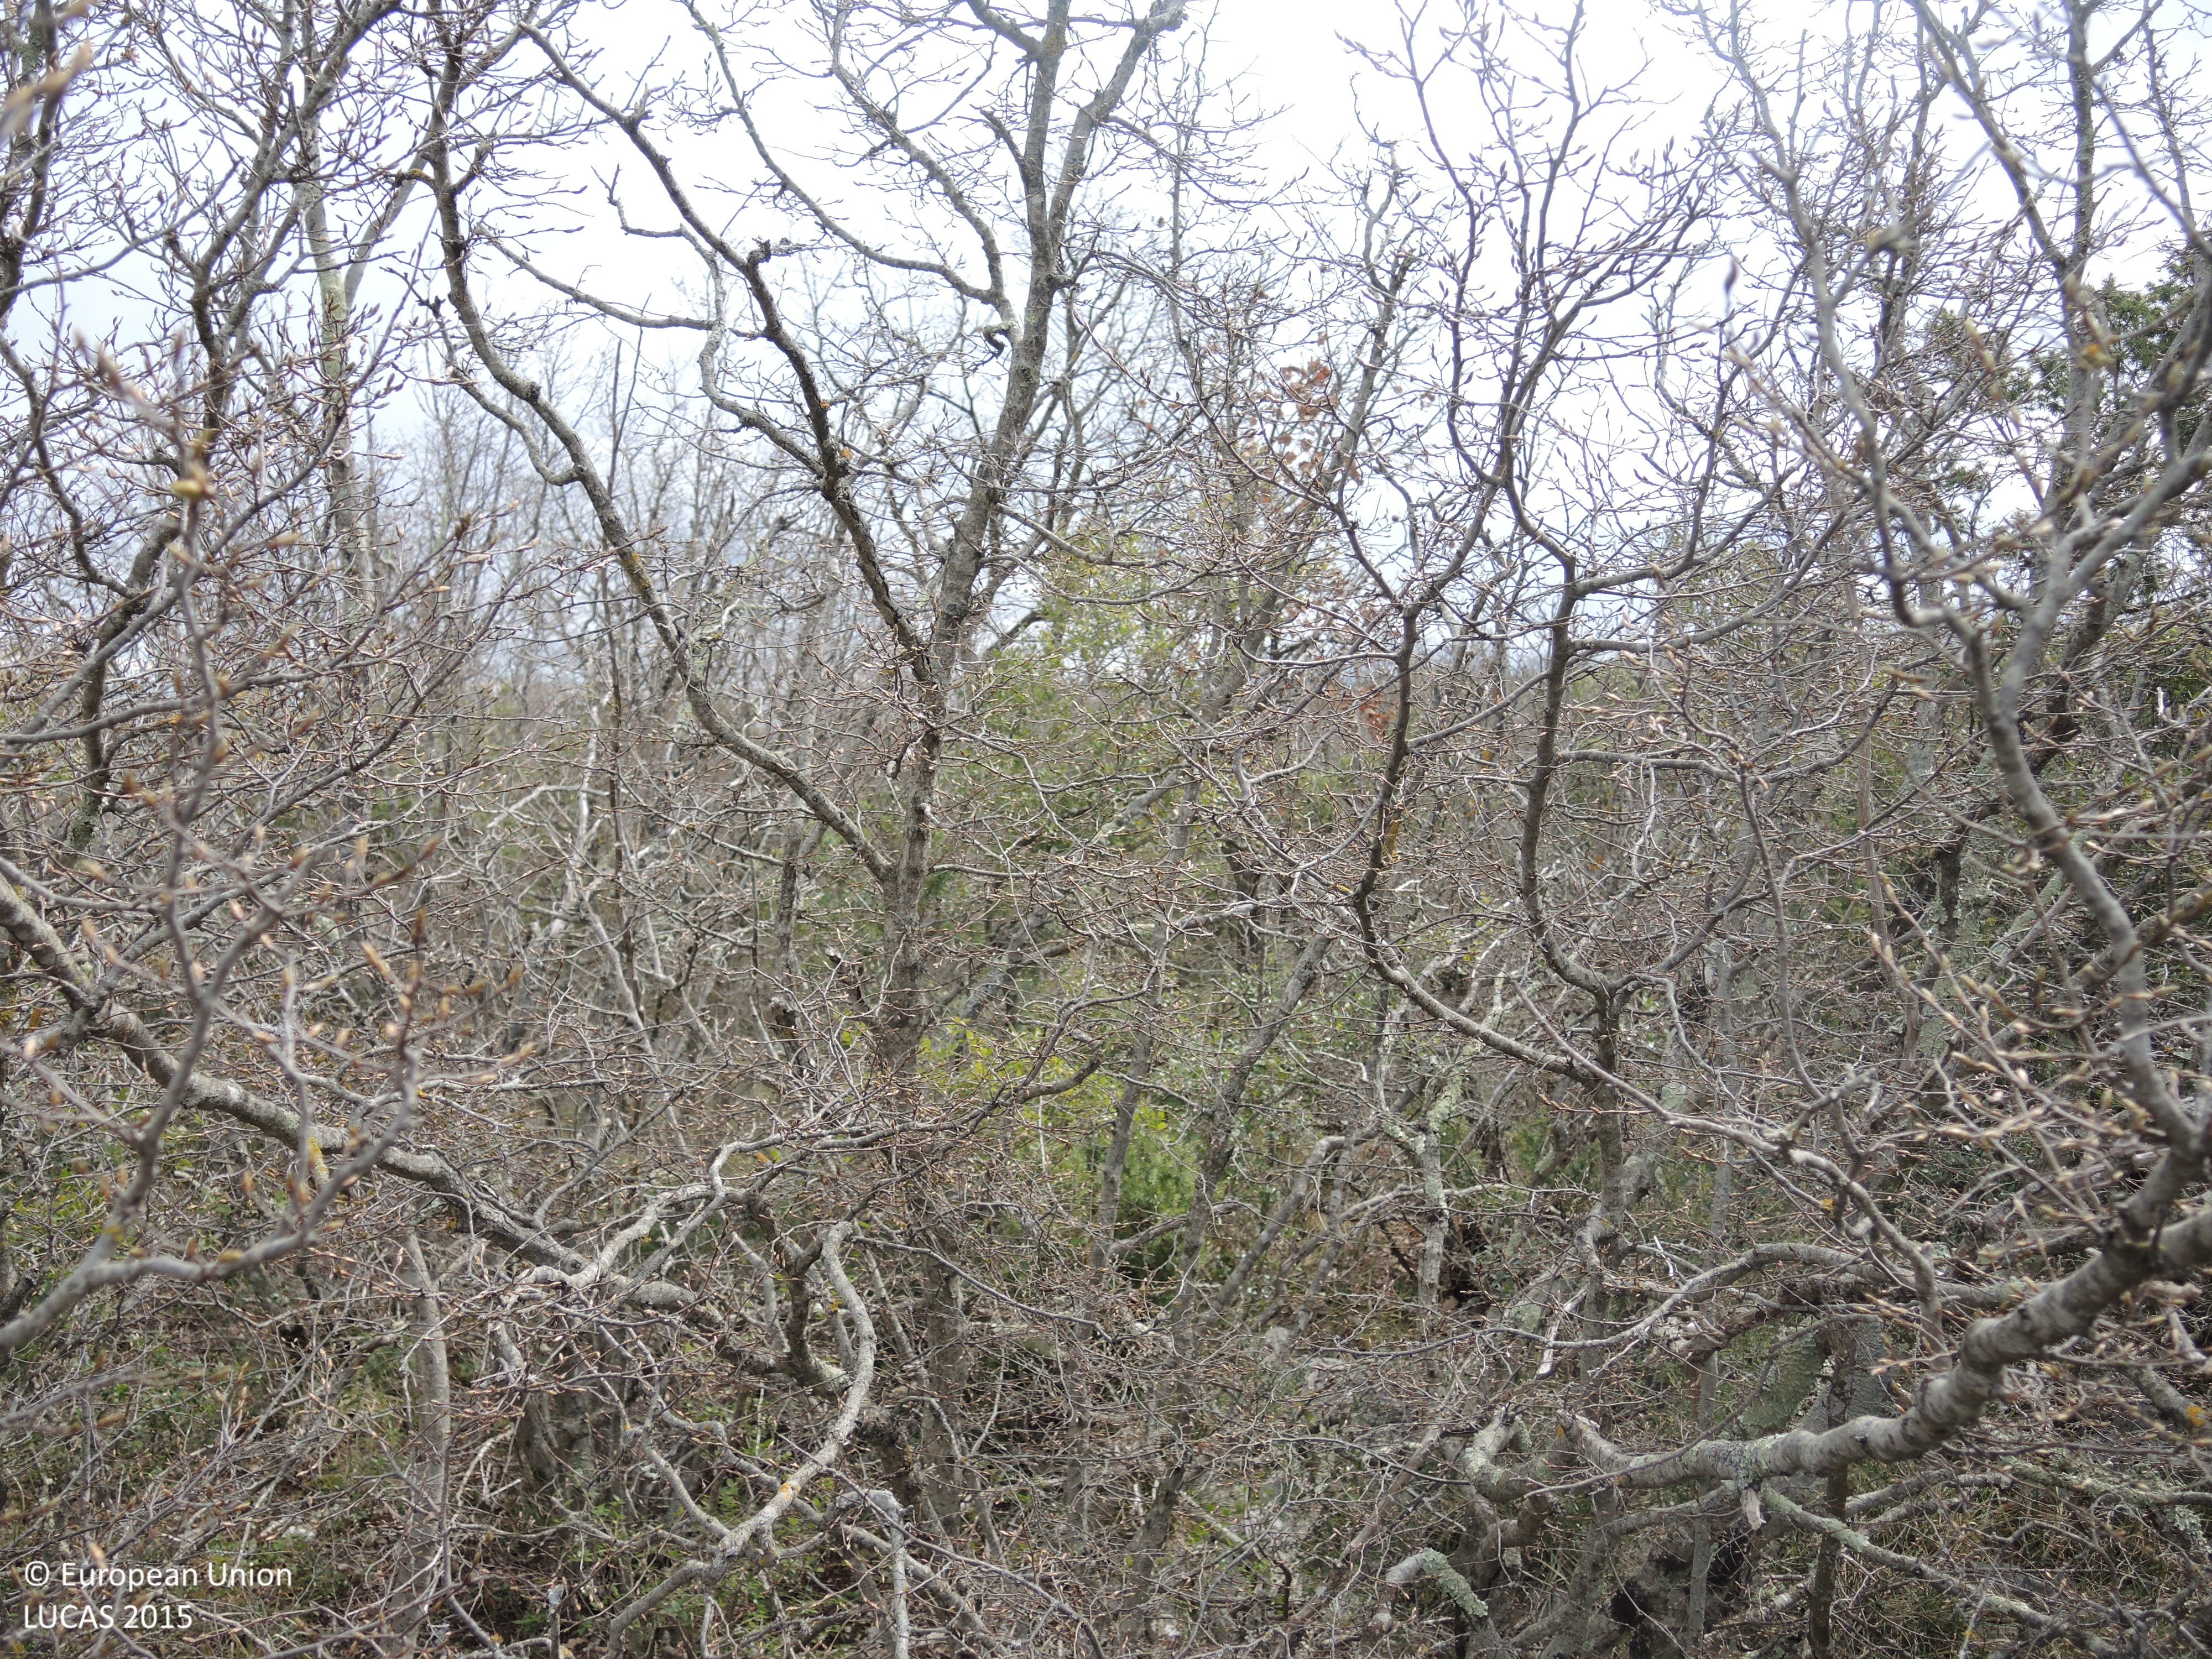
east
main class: Woodland
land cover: Other mixed woodland
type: mesophytic deciduous forest
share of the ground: > 75 %
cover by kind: broadleaved forest trees 30 %, shrubs 25 %, coniferous forest trees 20 %, consolidated bare surface 10 %, unconsolidated bare surface 10 %, herbaceous plants 5 %
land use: Semi-natural and natural areas not in use
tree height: < 5 m
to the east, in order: Other mixed woodland; Tracks; Other mixed woodland
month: April
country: HR
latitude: 43.8876
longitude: 15.6799
